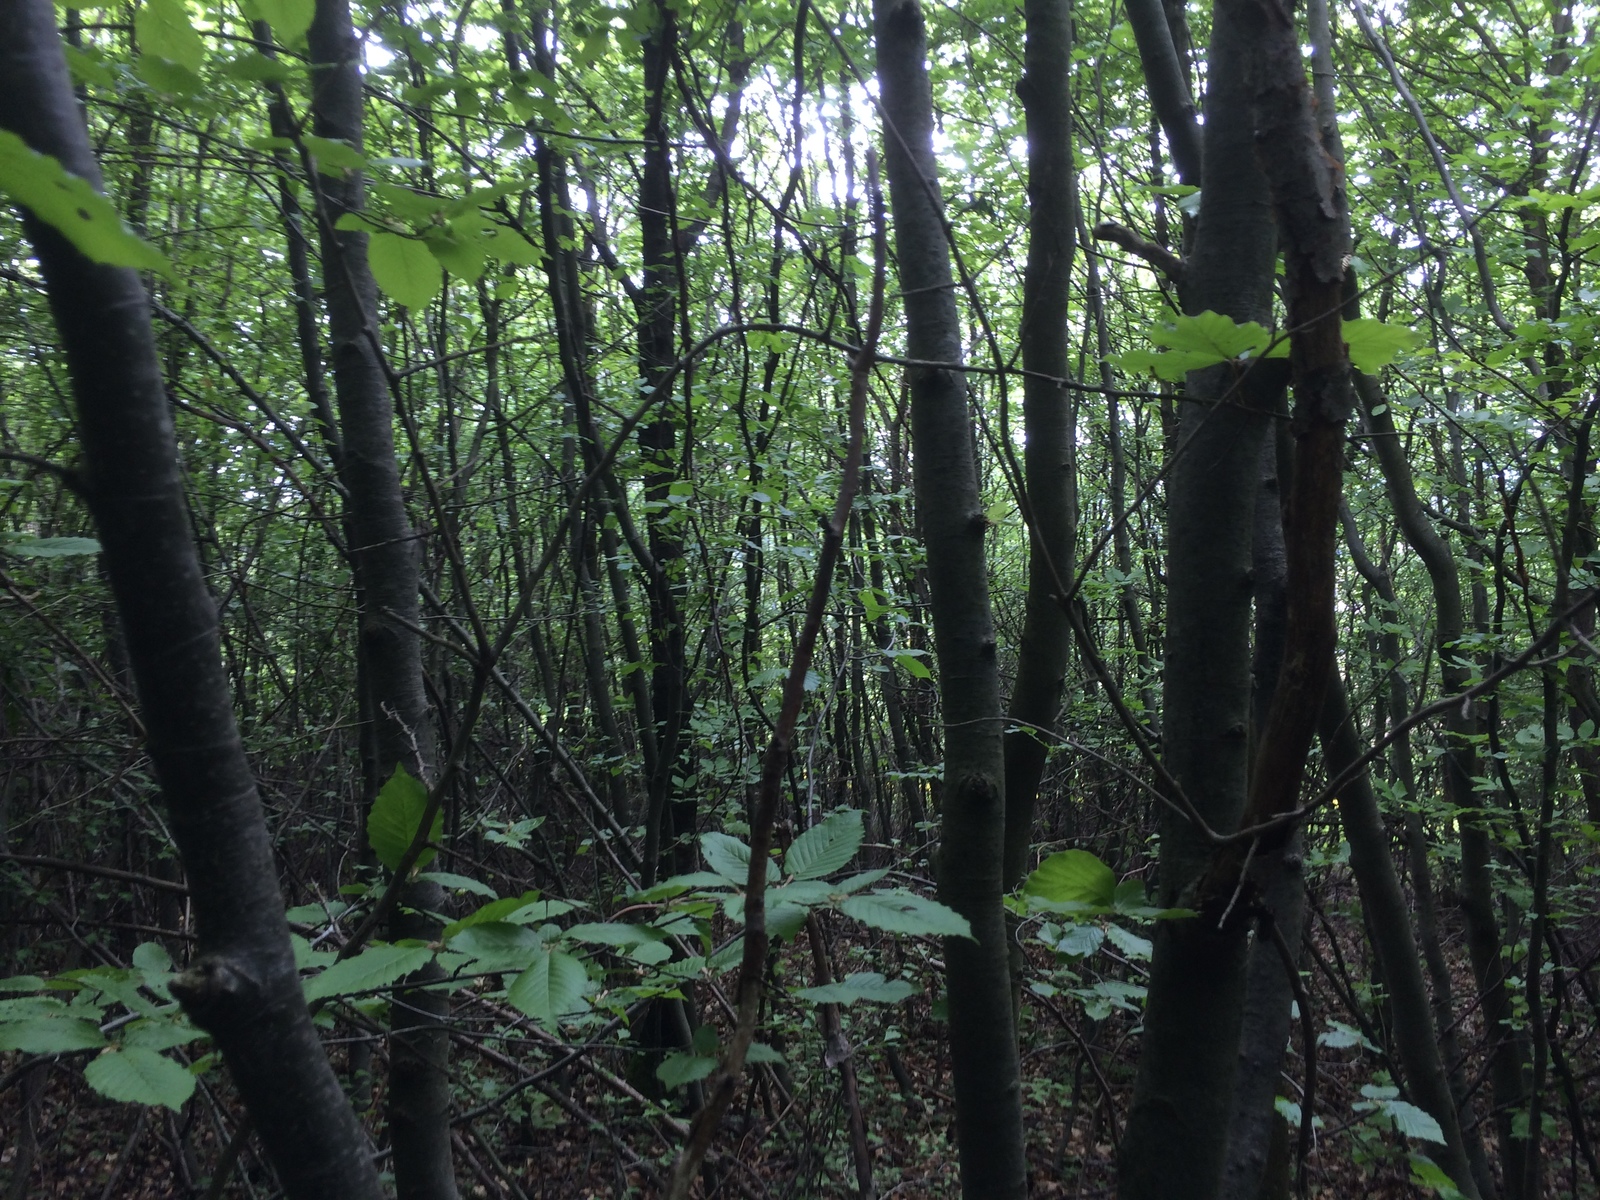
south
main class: Woodland
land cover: Broadleaved woodland
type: beech forest
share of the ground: > 75 %
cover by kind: broadleaved forest trees 100 %
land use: Forestry
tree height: > 5 m
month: May
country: AT
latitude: 48.0885
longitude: 16.1394
